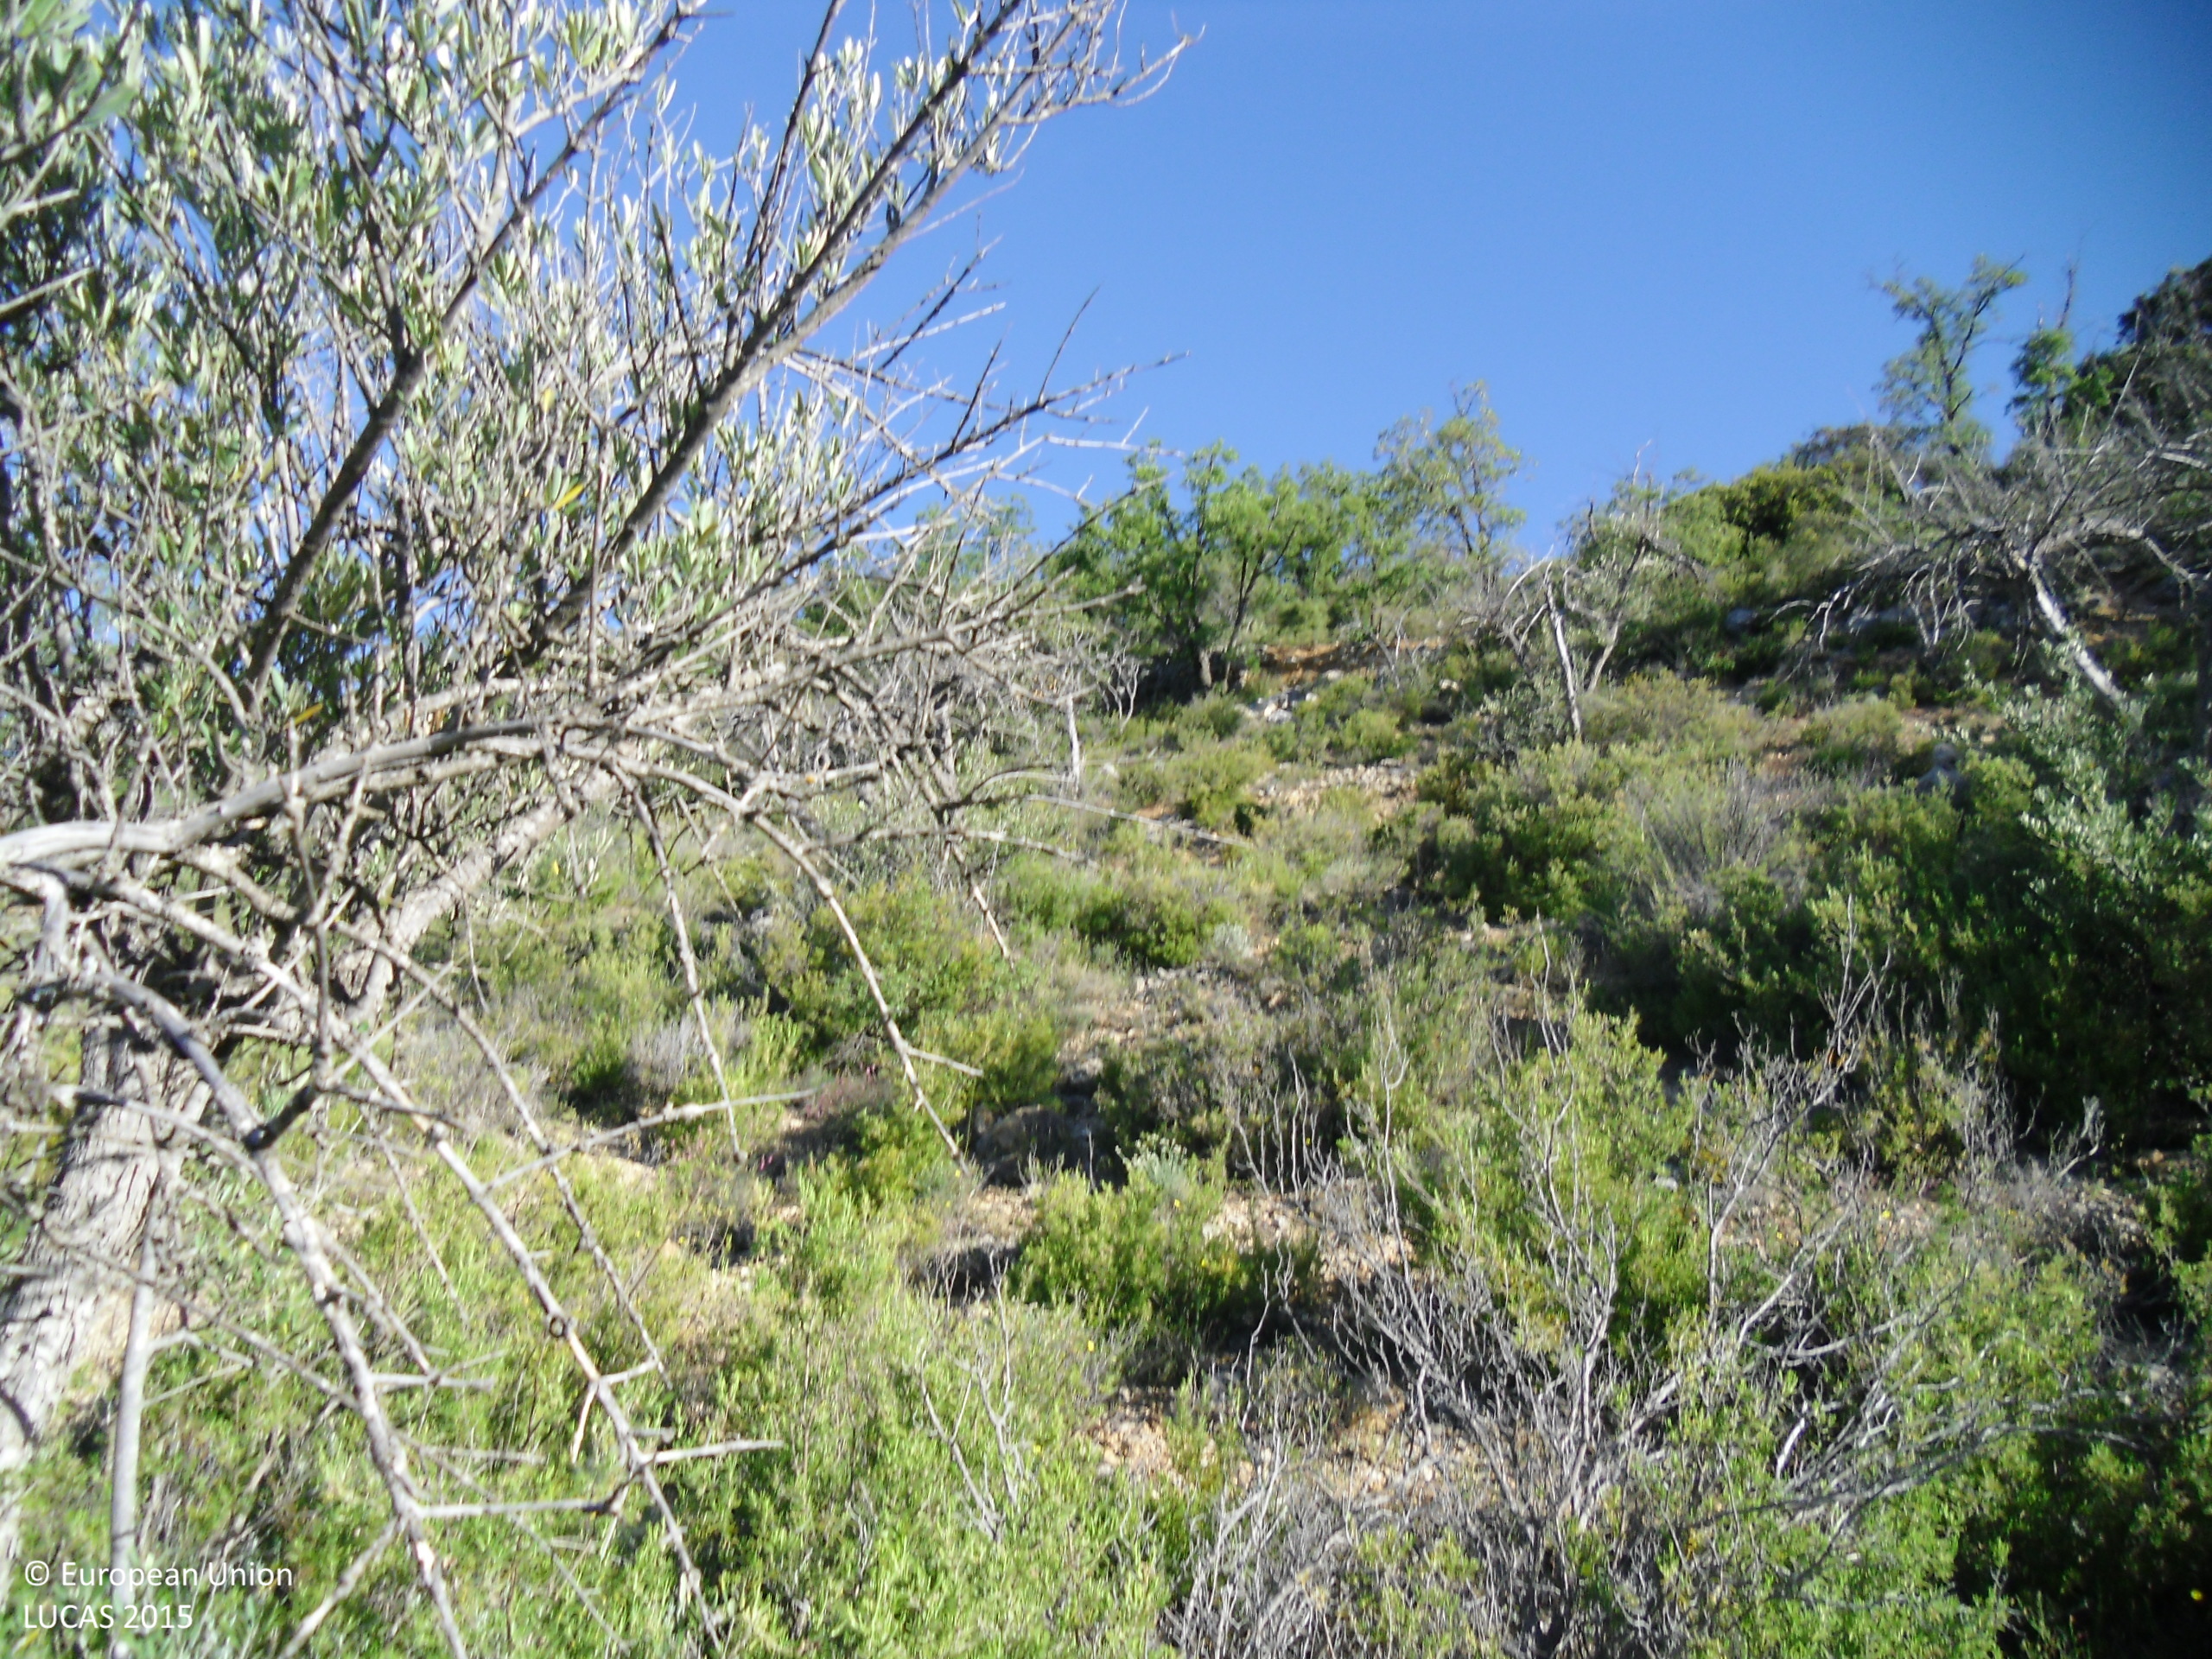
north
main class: Cropland
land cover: Olive groves
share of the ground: 25 - 50 %
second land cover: Shrubland without tree cover
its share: > 75 %
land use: Abandoned areas
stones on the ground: 10 - 25 %
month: May
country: ES
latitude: 40.6482
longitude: -2.9567
